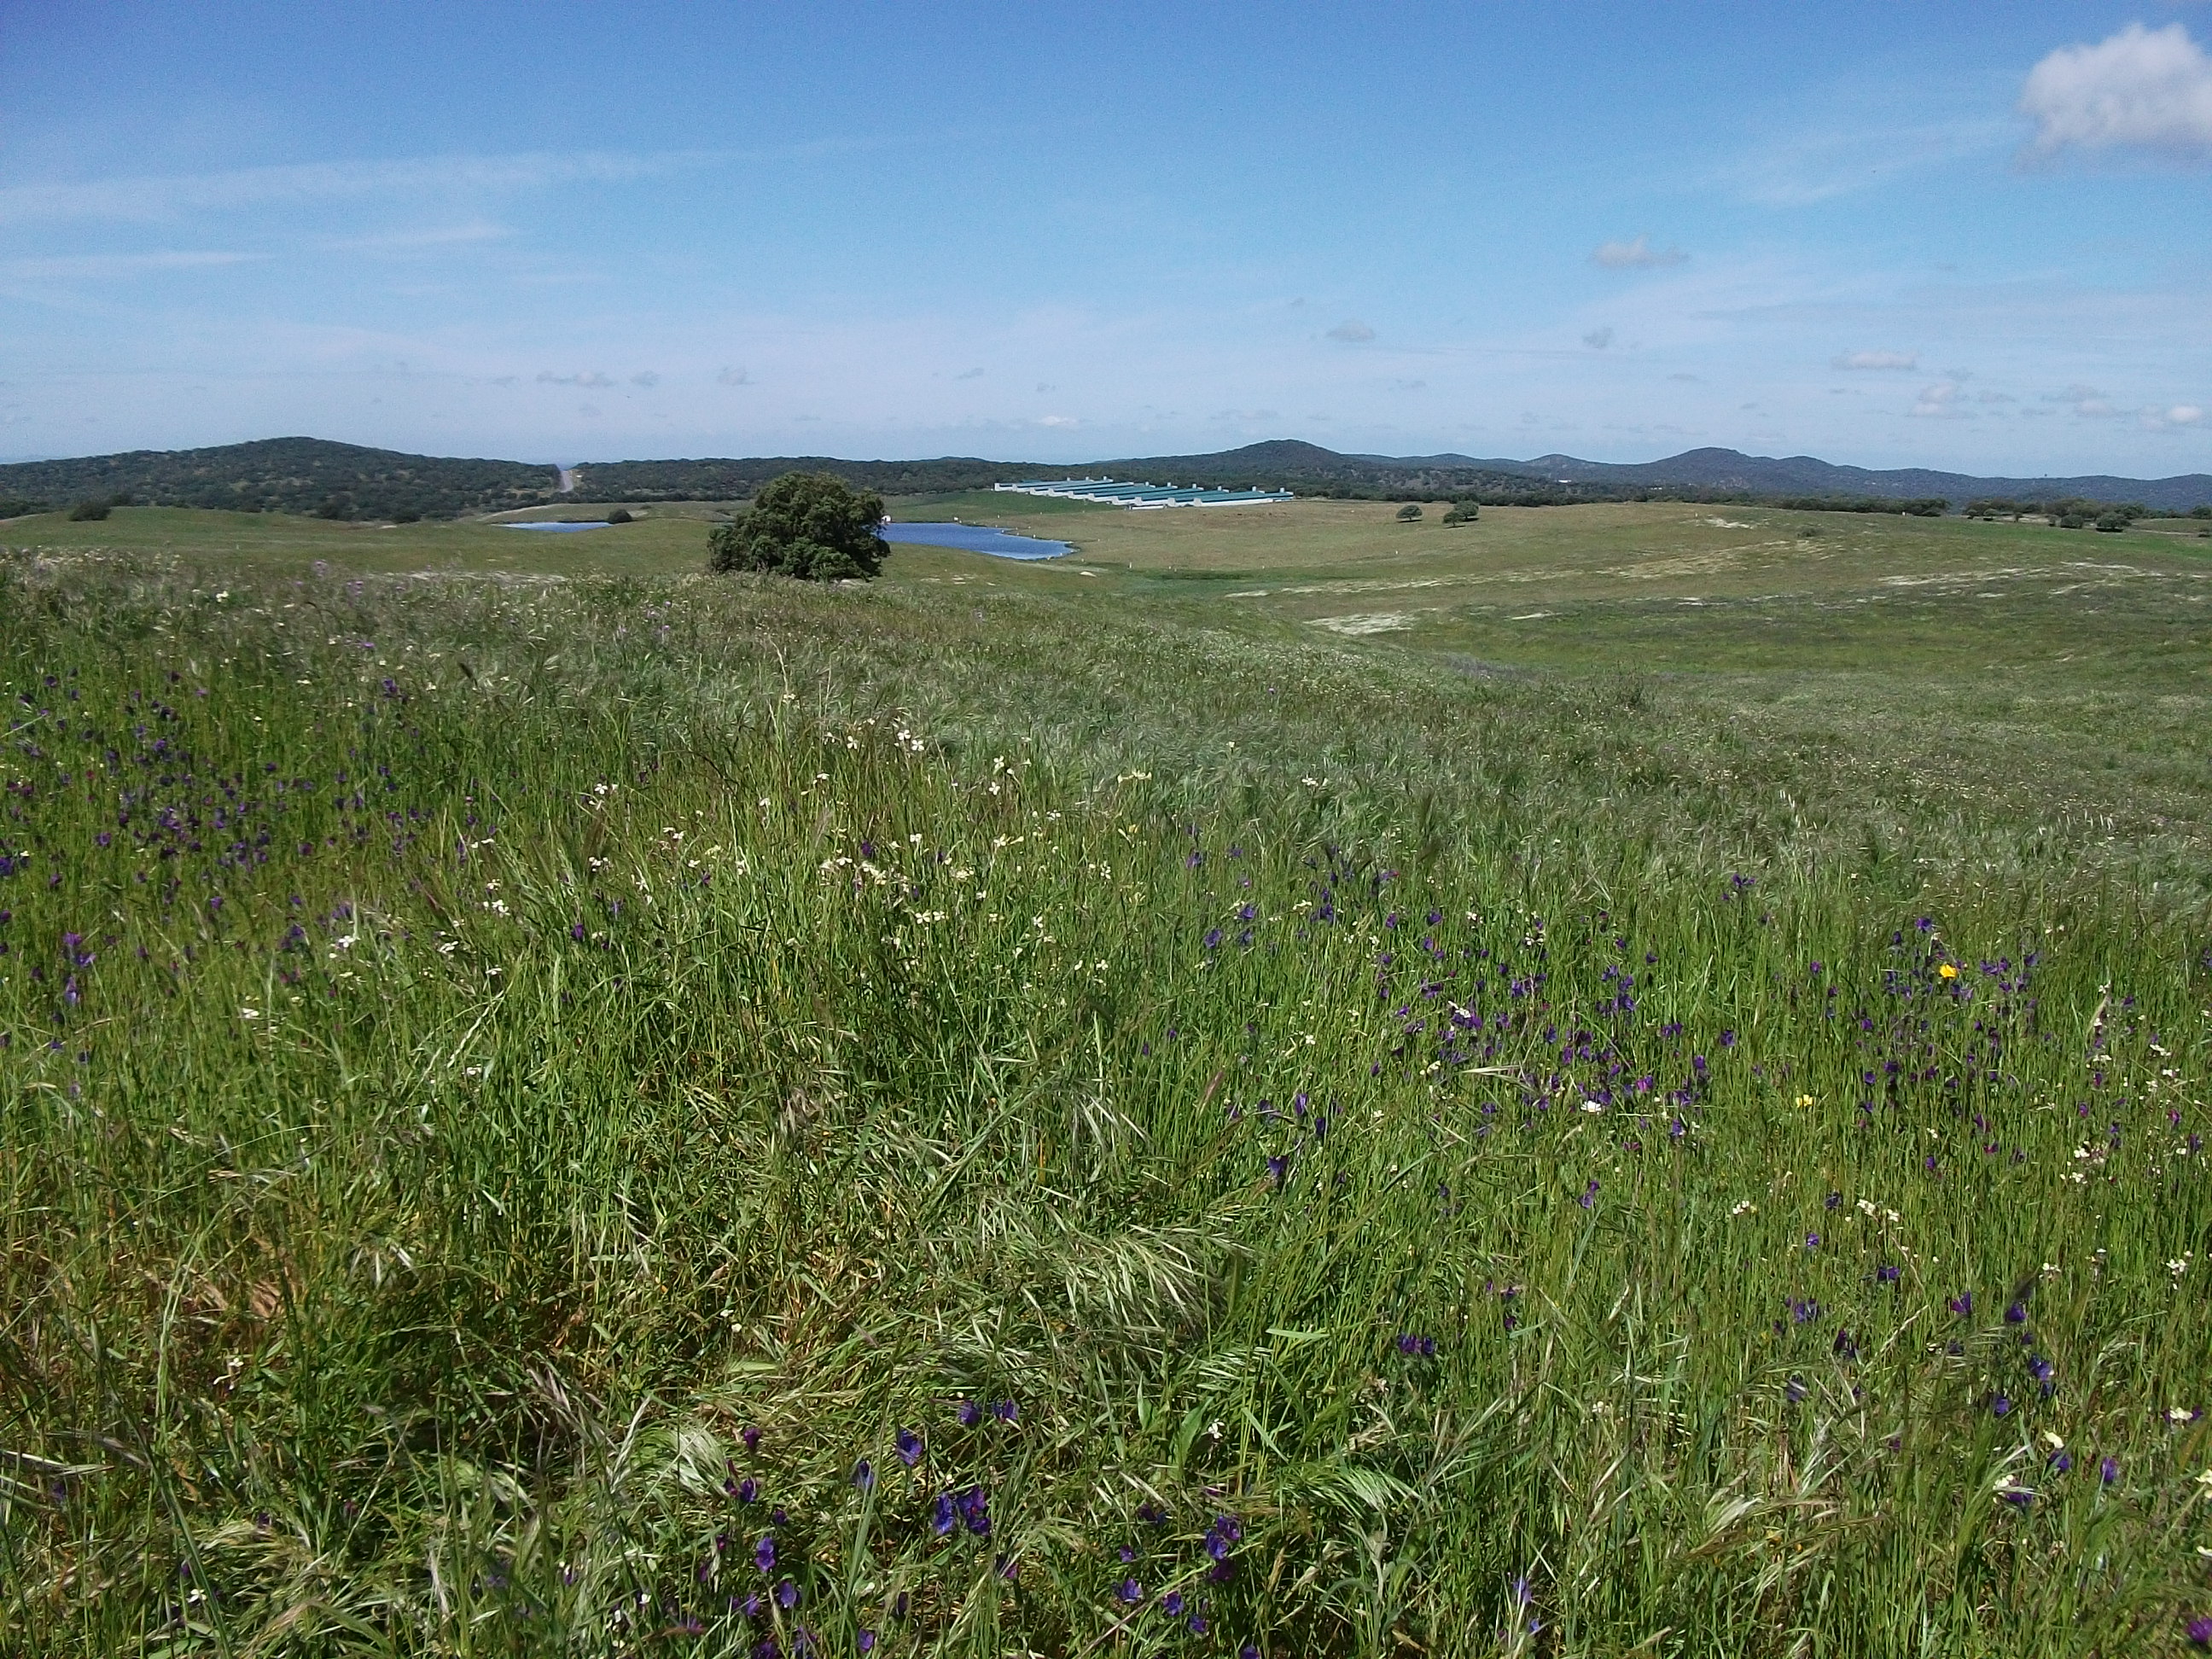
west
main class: Grassland
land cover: Grassland without tree/shrub cover
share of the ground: > 75 %
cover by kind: herbaceous plants 100 %
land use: Agriculture (excluding fallow land and kitchen gardens)
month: April
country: ES
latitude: 38.1661
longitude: -6.7738
